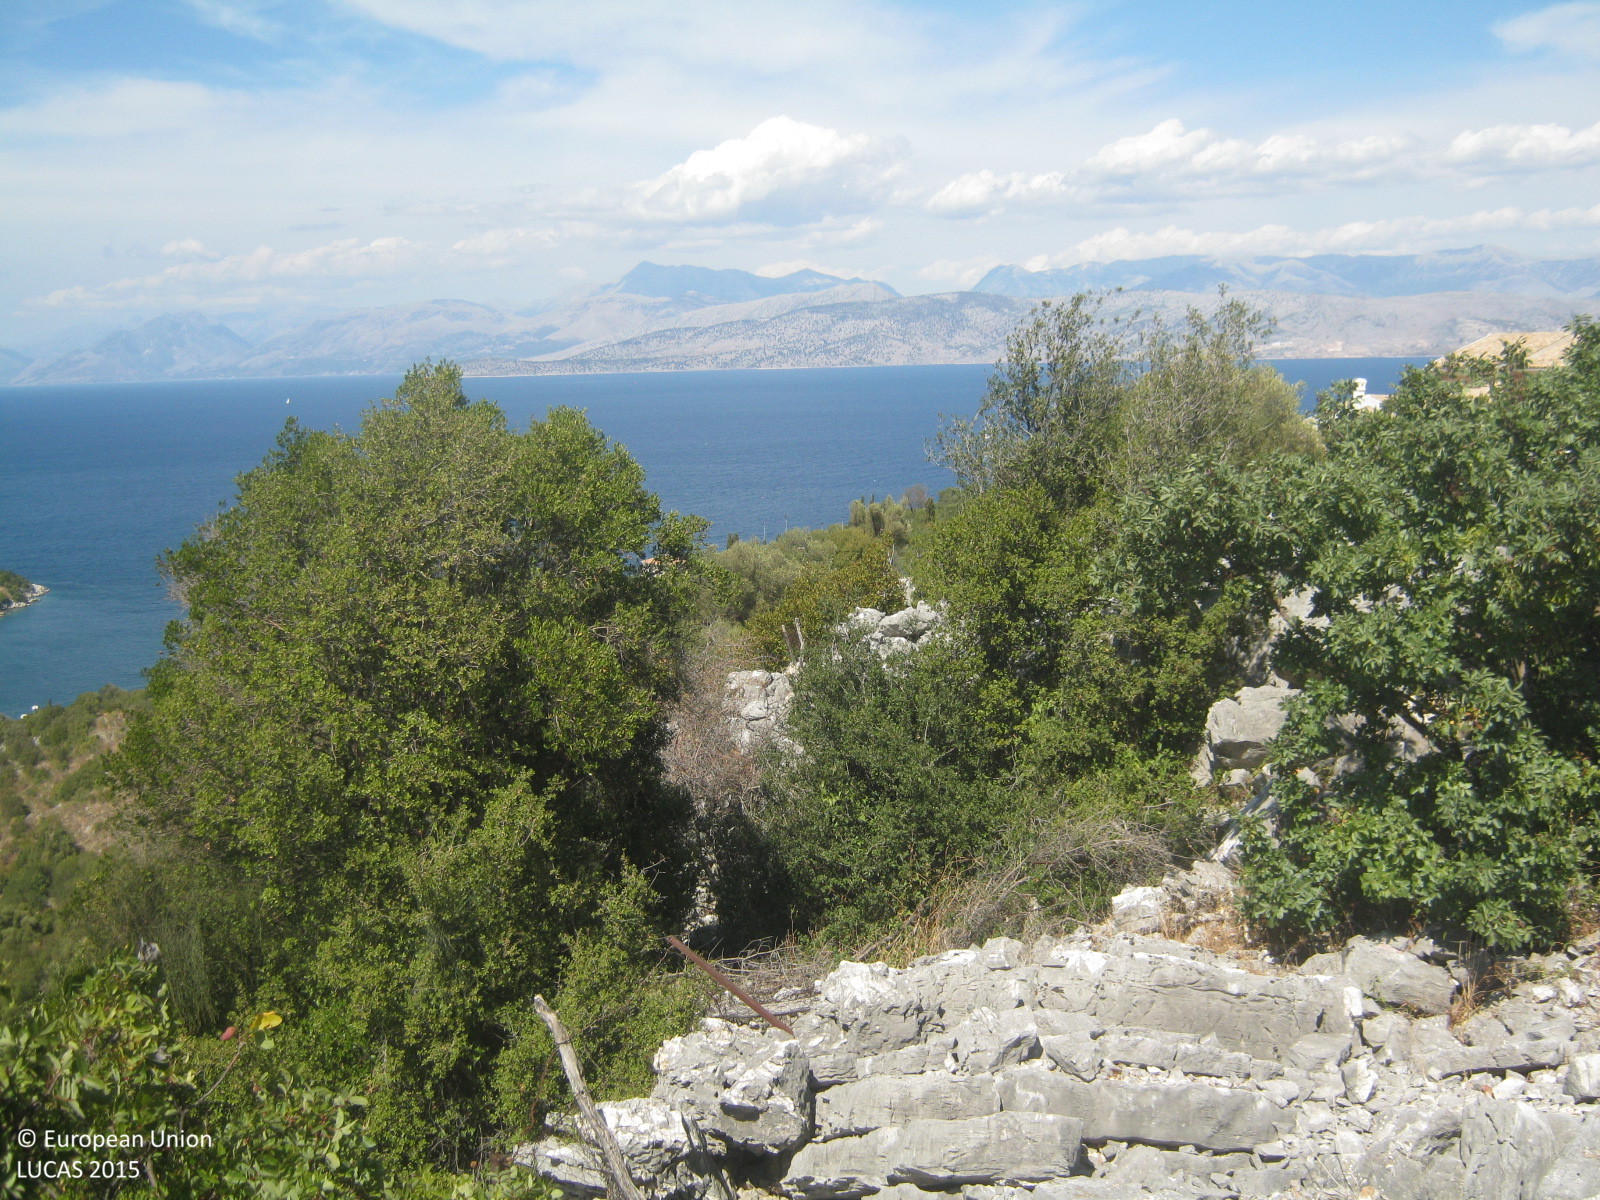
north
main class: Shrubland
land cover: Shrubland without tree cover
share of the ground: 25 - 50 %
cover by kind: herbaceous plants 60 %, shrubs 30 %, consolidated bare surface 10 %
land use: Semi-natural and natural areas not in use
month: September
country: GR
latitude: 39.7824
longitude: 19.9117
